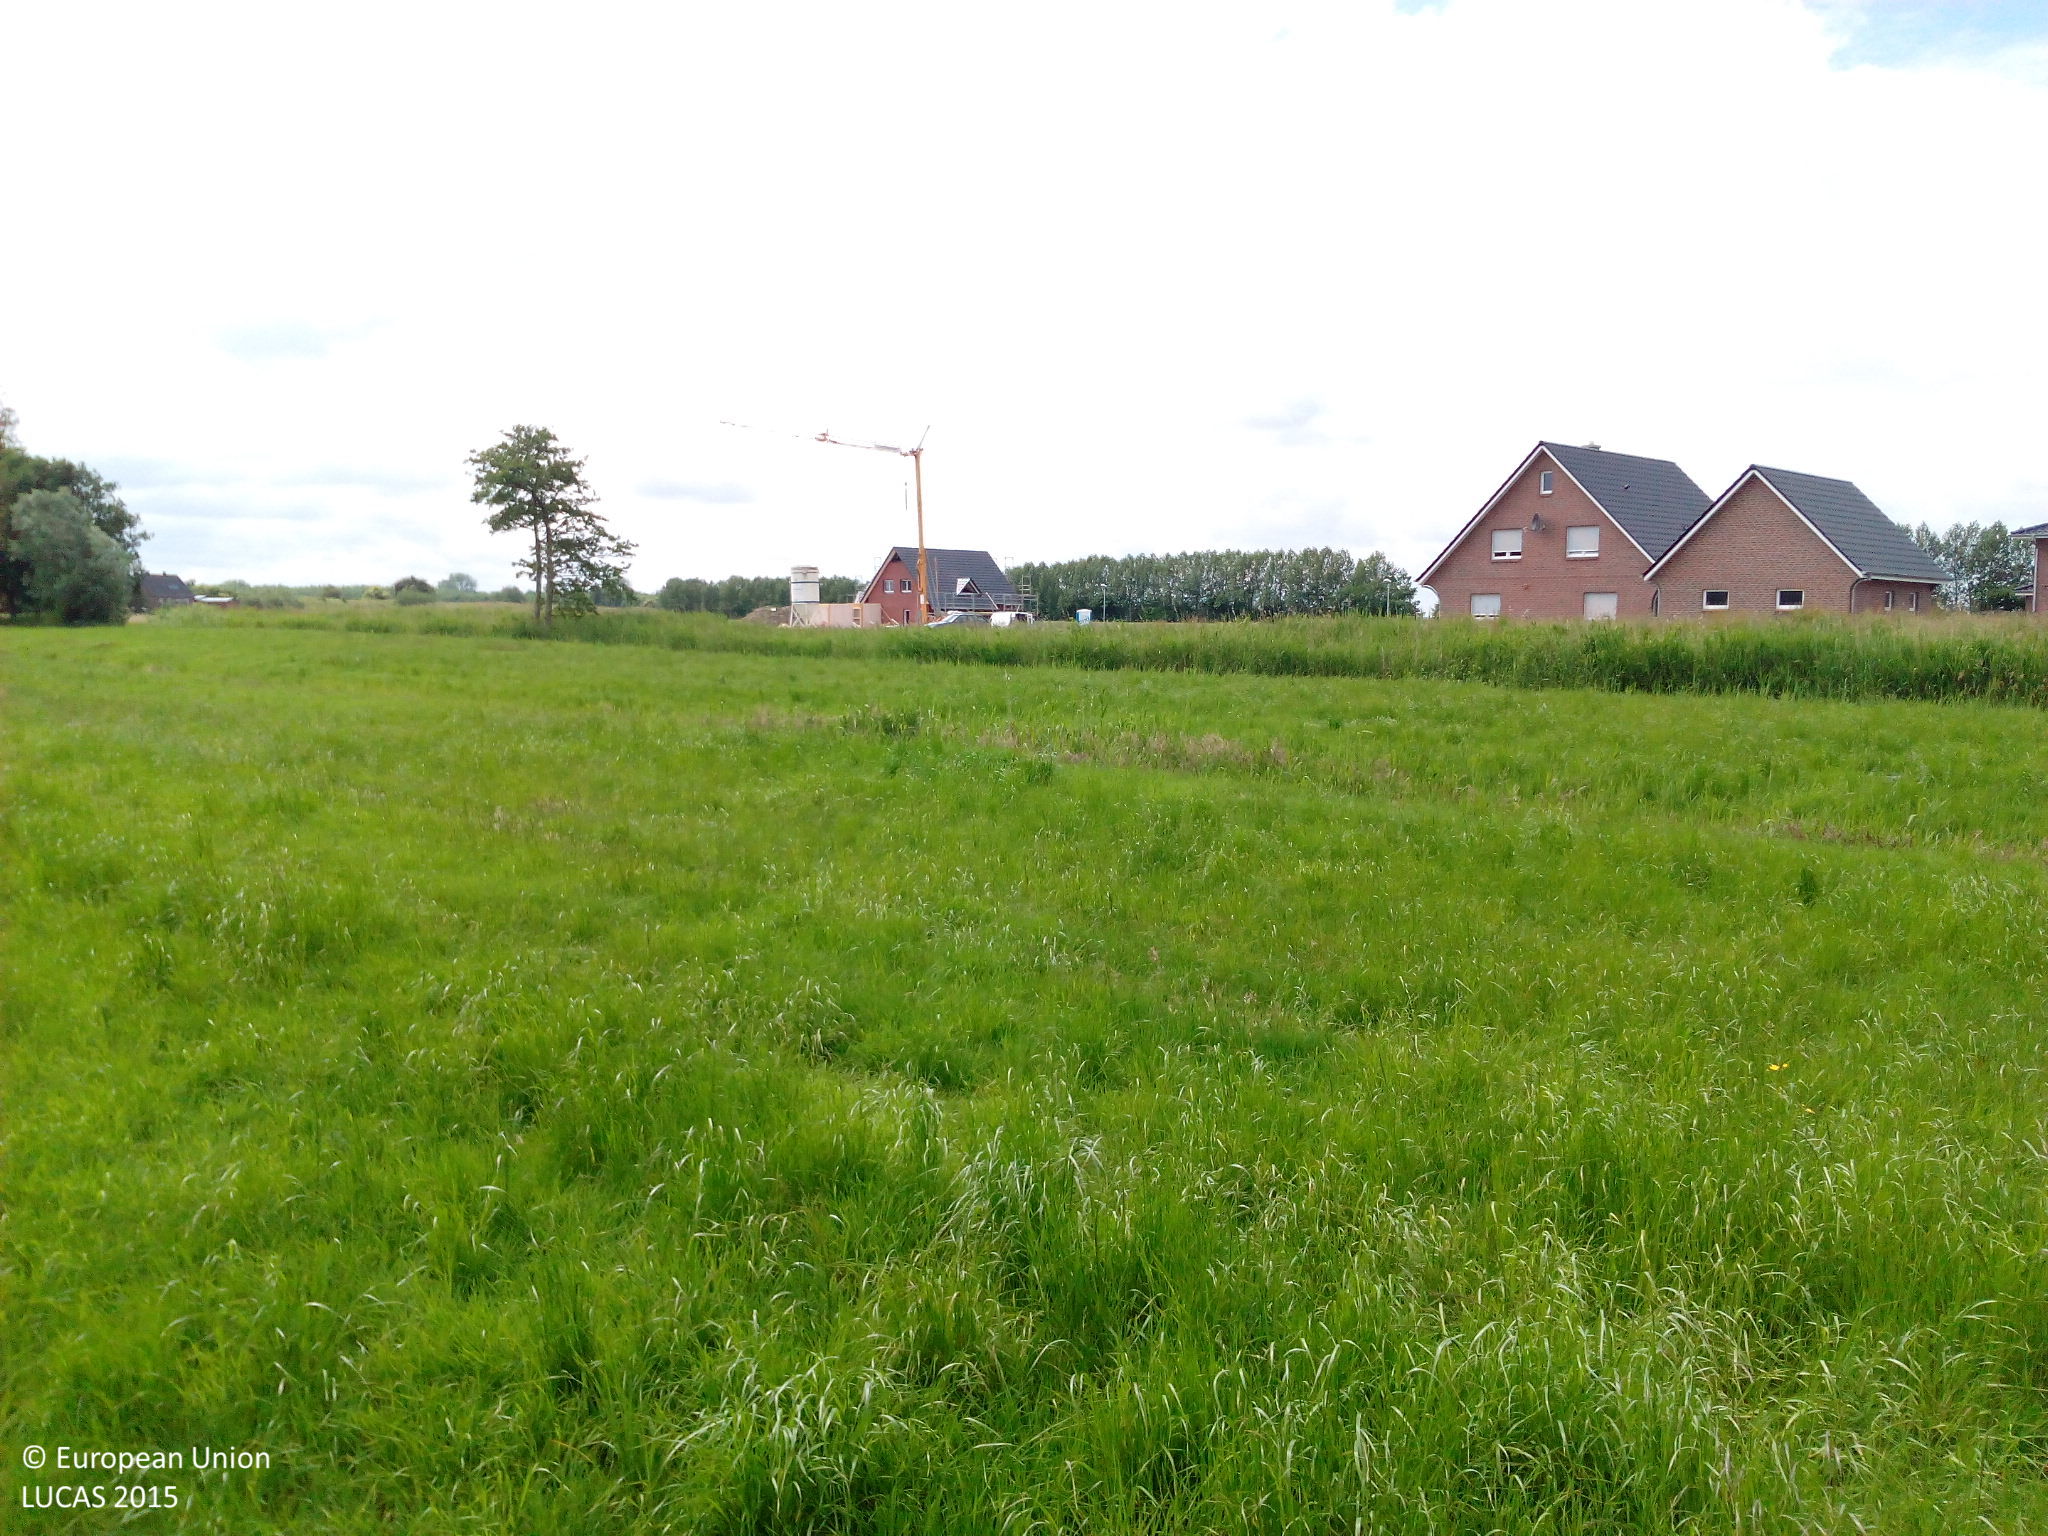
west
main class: Grassland
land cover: Grassland without tree/shrub cover
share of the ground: > 75 %
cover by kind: herbaceous plants 100 %
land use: Agriculture (excluding fallow land and kitchen gardens)
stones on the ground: < 10 %
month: June
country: DE
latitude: 53.7774
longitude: 9.3175
